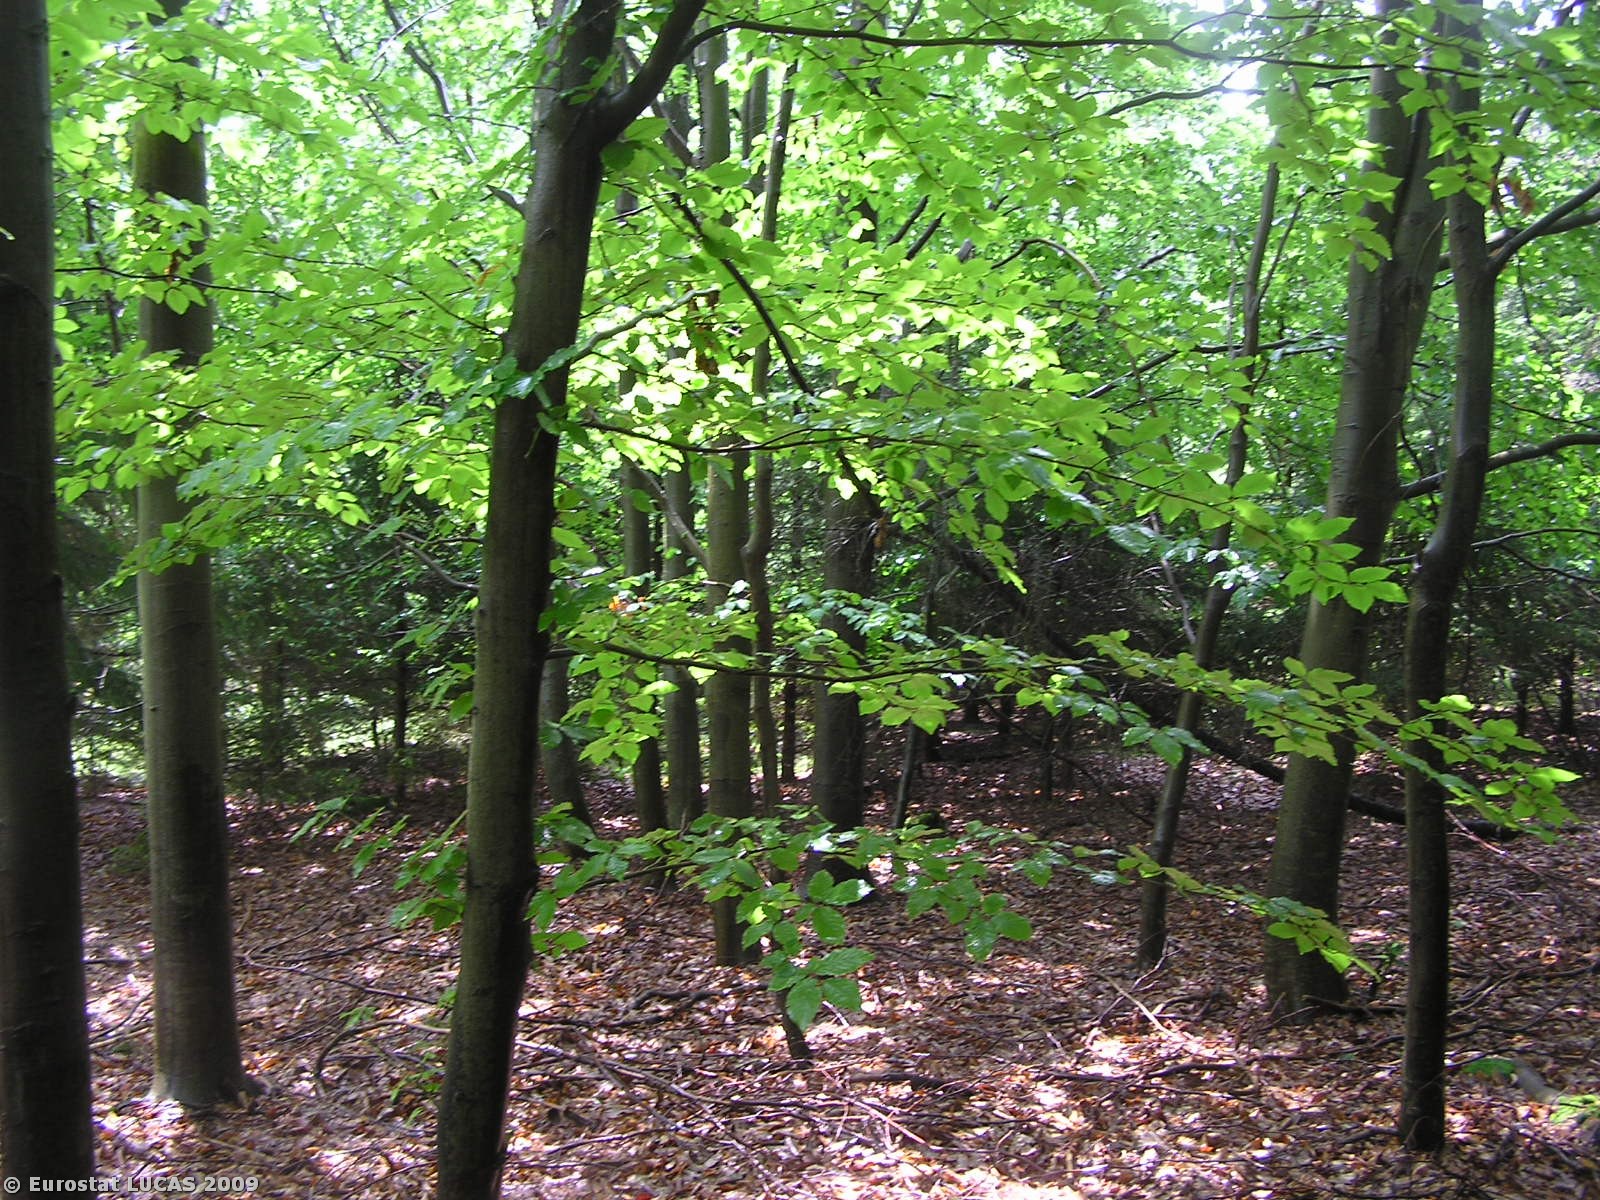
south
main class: Woodland
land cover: Broadleaved woodland
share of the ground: > 75 %
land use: Forestry
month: June
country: CZ
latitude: 49.6780
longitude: 15.0055
